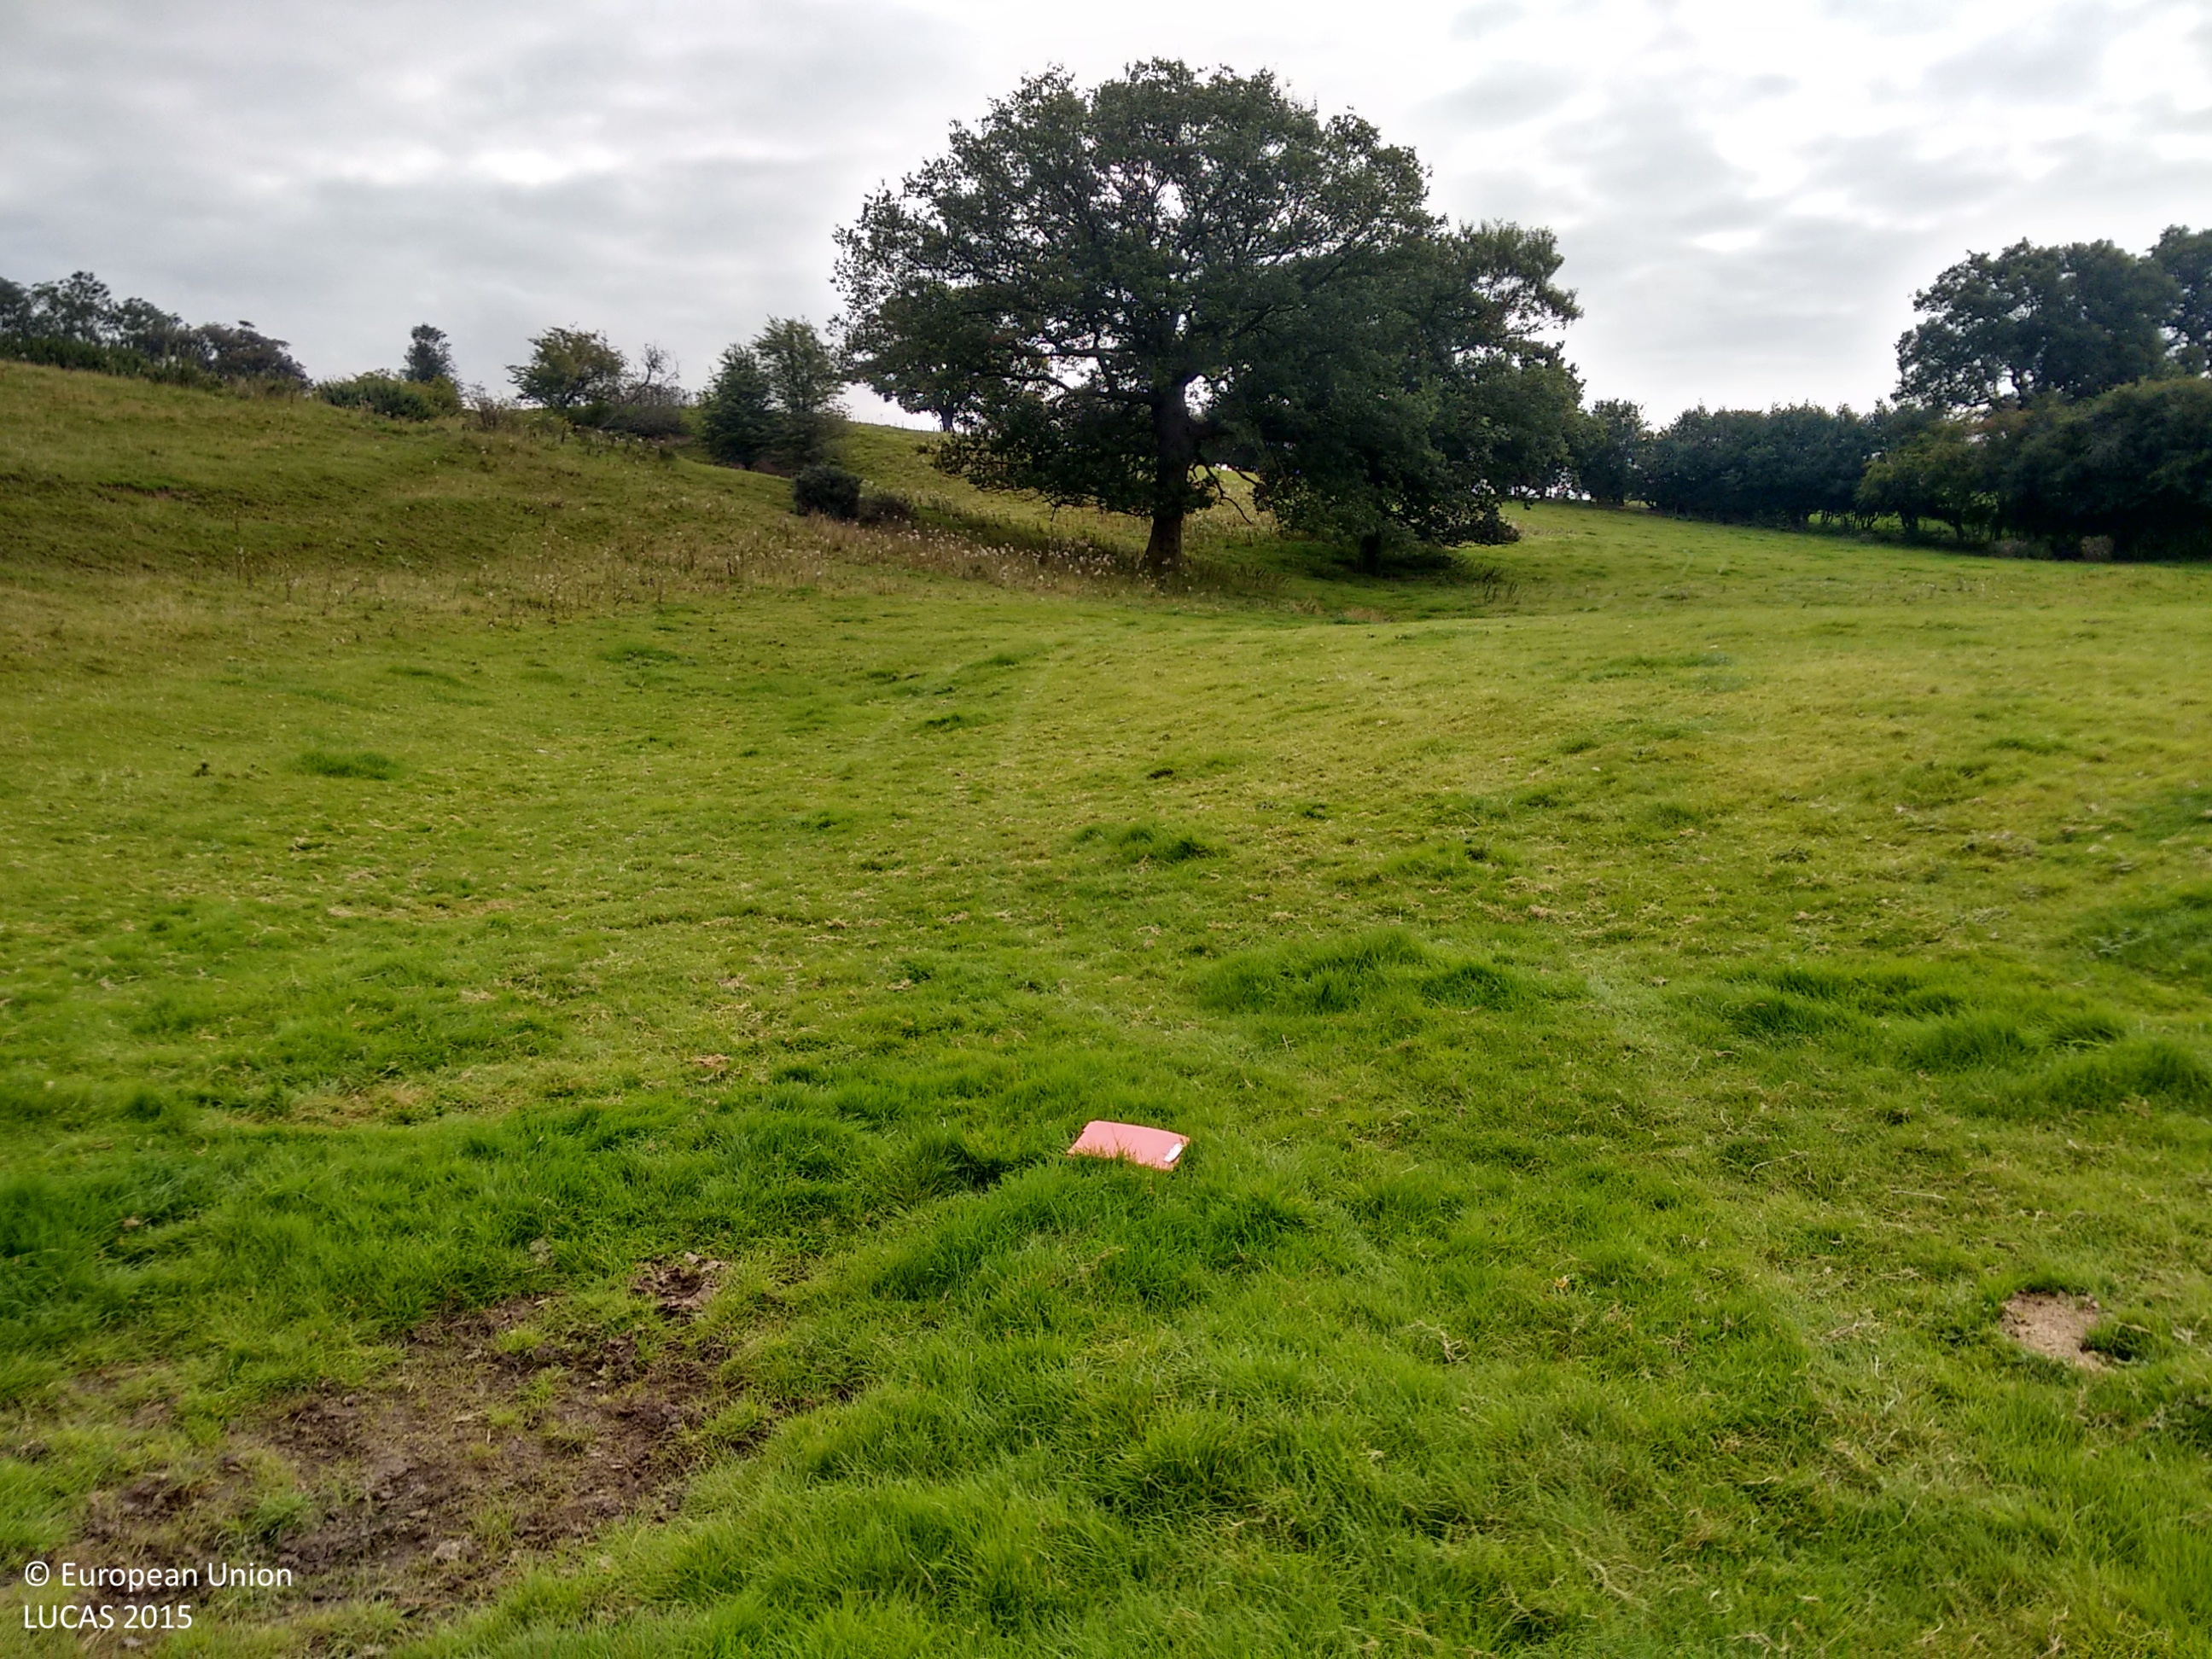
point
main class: Grassland
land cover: Grassland without tree/shrub cover
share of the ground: > 75 %
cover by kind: herbaceous plants 100 %
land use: Agriculture (excluding fallow land and kitchen gardens)
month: September
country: GB
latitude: 52.8728
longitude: -2.8944
